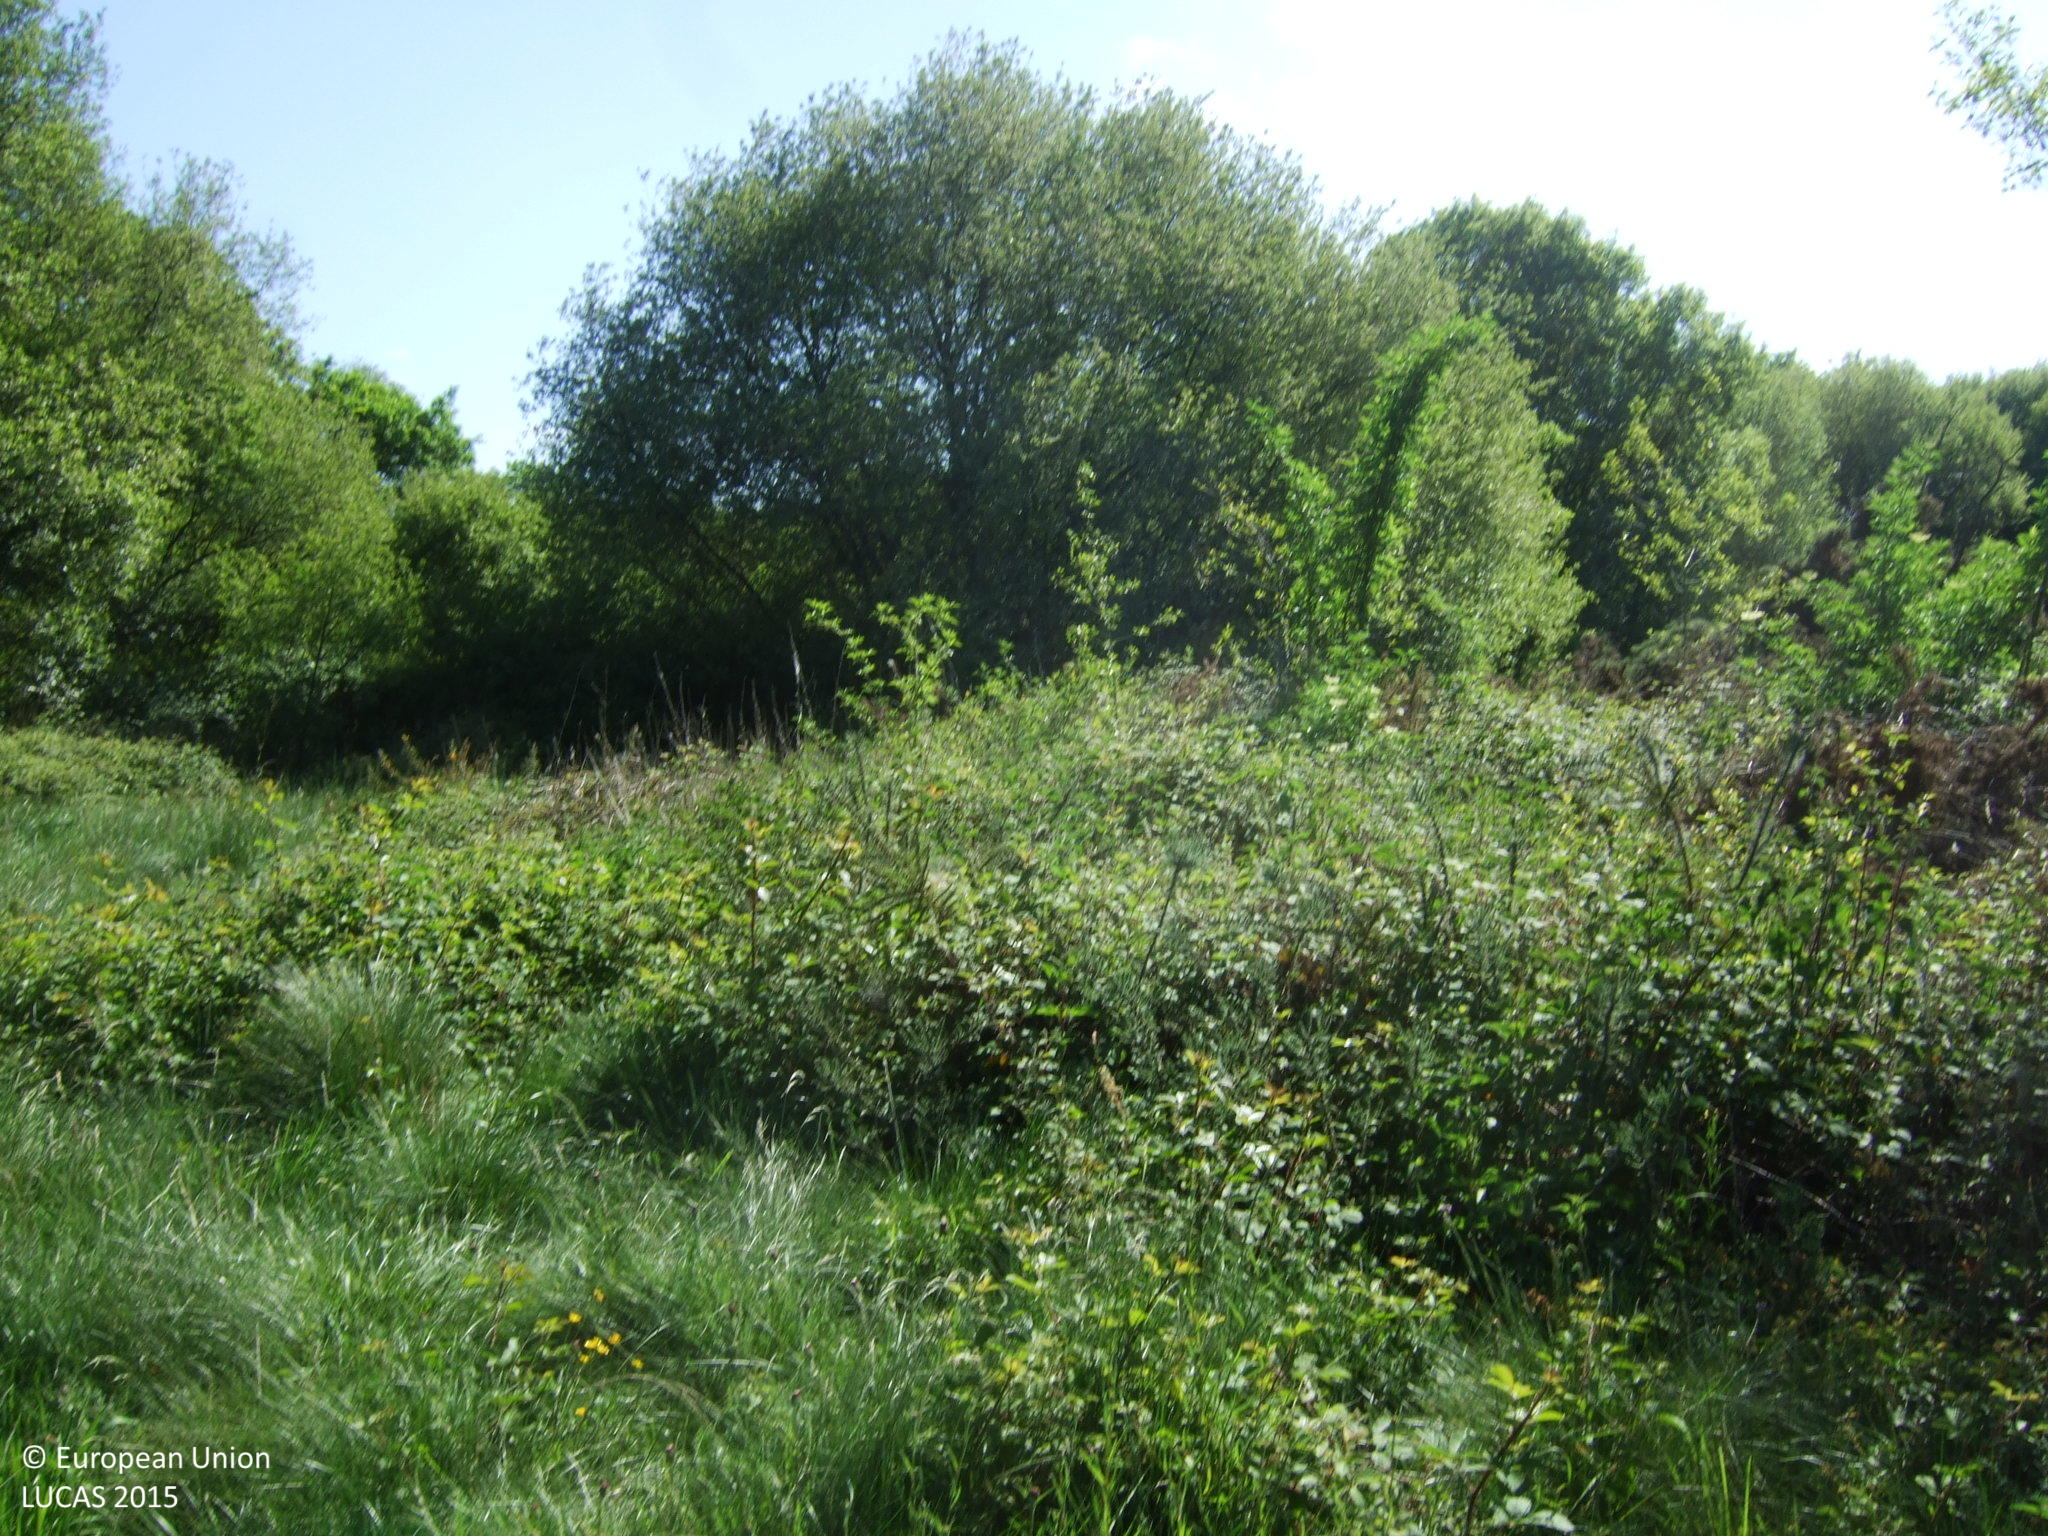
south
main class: Shrubland
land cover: Shrubland with sparse tree cover
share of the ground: > 75 %
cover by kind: shrubs 95 %, broadleaved forest trees 5 %
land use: Abandoned areas
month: May
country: ES
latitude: 43.2007
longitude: -7.4920
